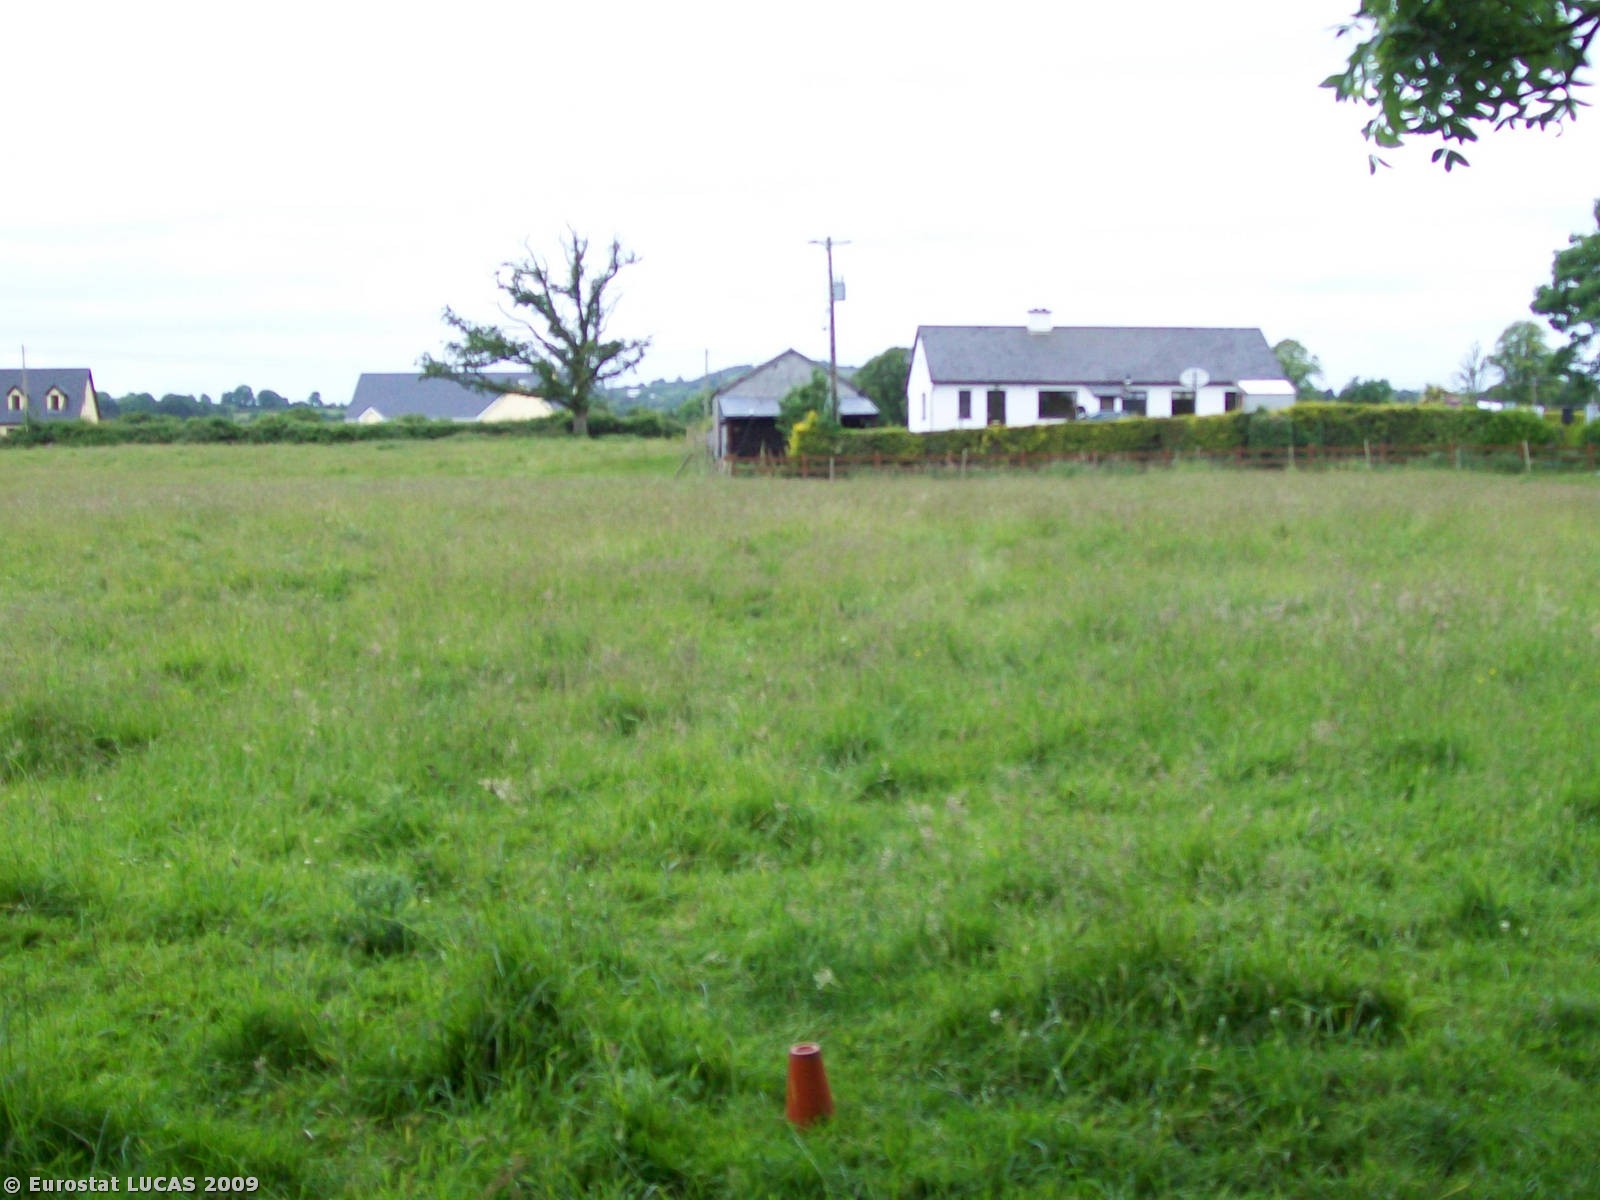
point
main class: Grassland
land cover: Grassland without tree/shrub cover
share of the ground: > 75 %
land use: Agriculture (excluding fallow land and kitchen gardens)
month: June
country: IE
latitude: 53.1612
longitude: -8.4847
